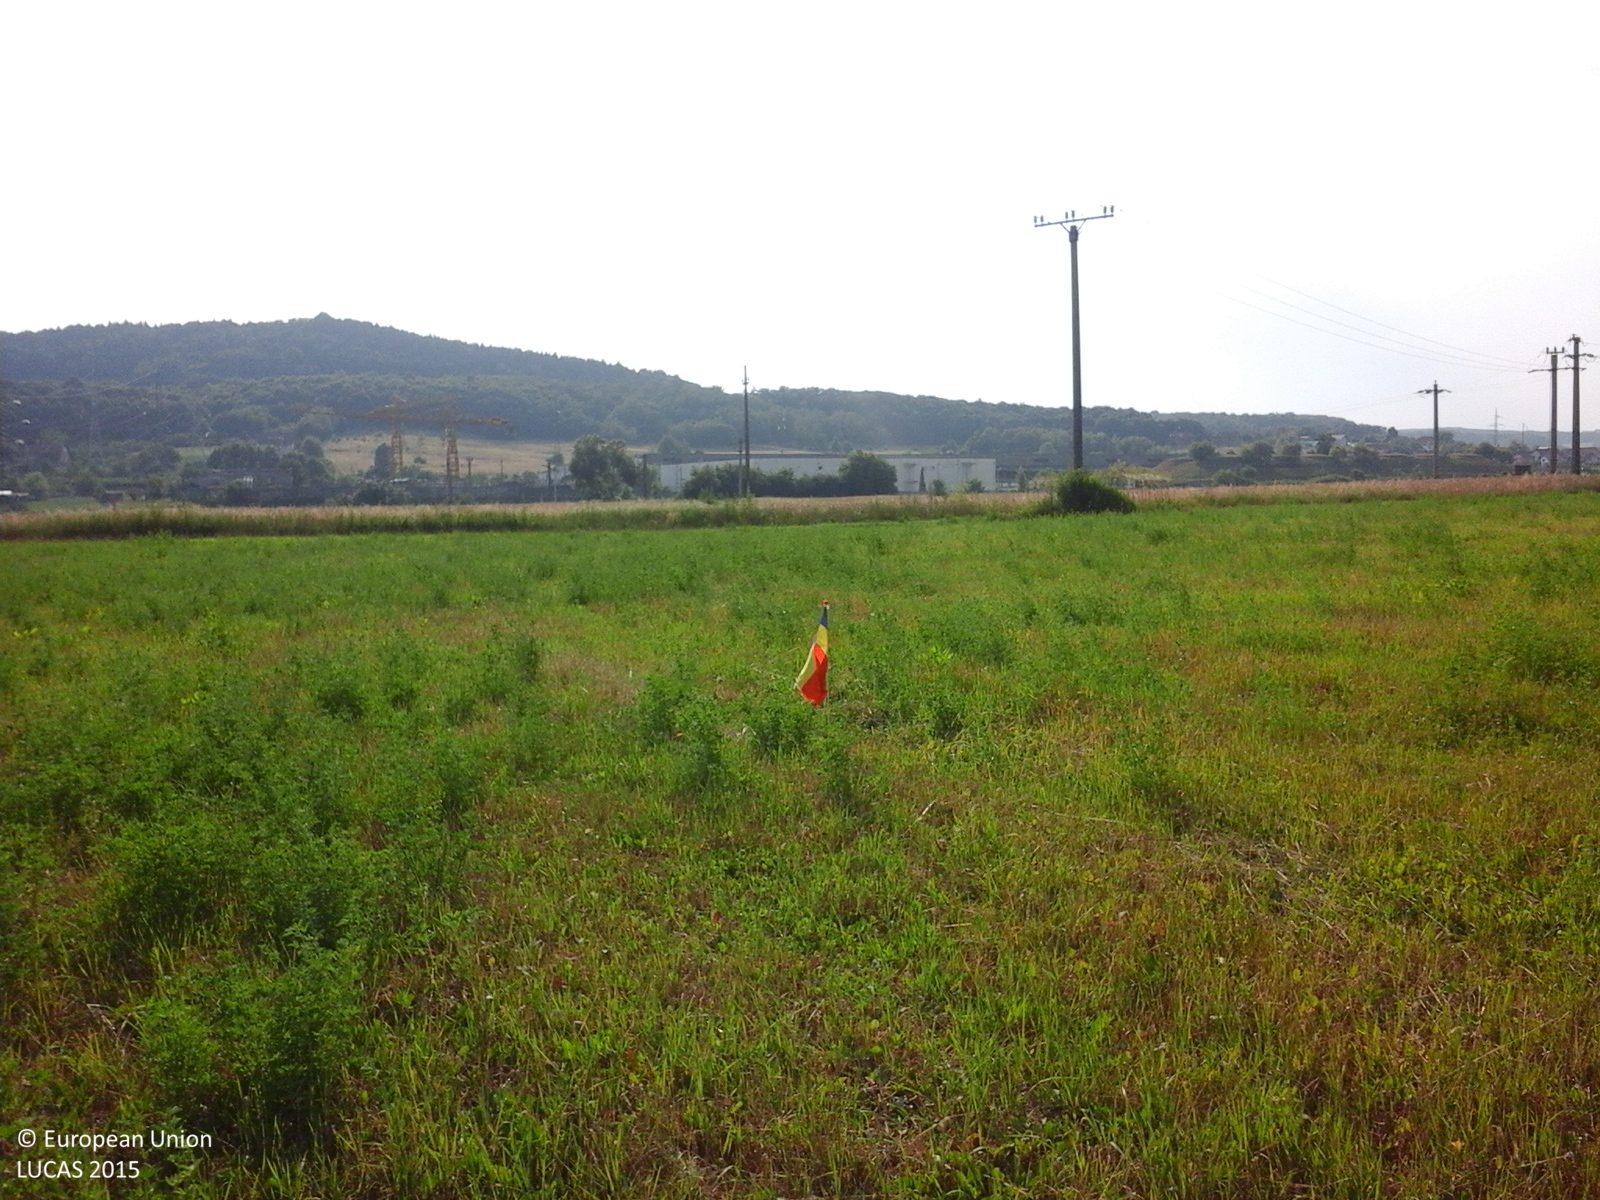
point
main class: Cropland
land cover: Lucerne
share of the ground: > 75 %
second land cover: Spontaneously vegetated surfaces
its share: 10 - 25 %
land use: Agriculture (excluding fallow land and kitchen gardens)
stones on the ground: < 10 %
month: July
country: RO
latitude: 45.1149
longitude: 24.6594
